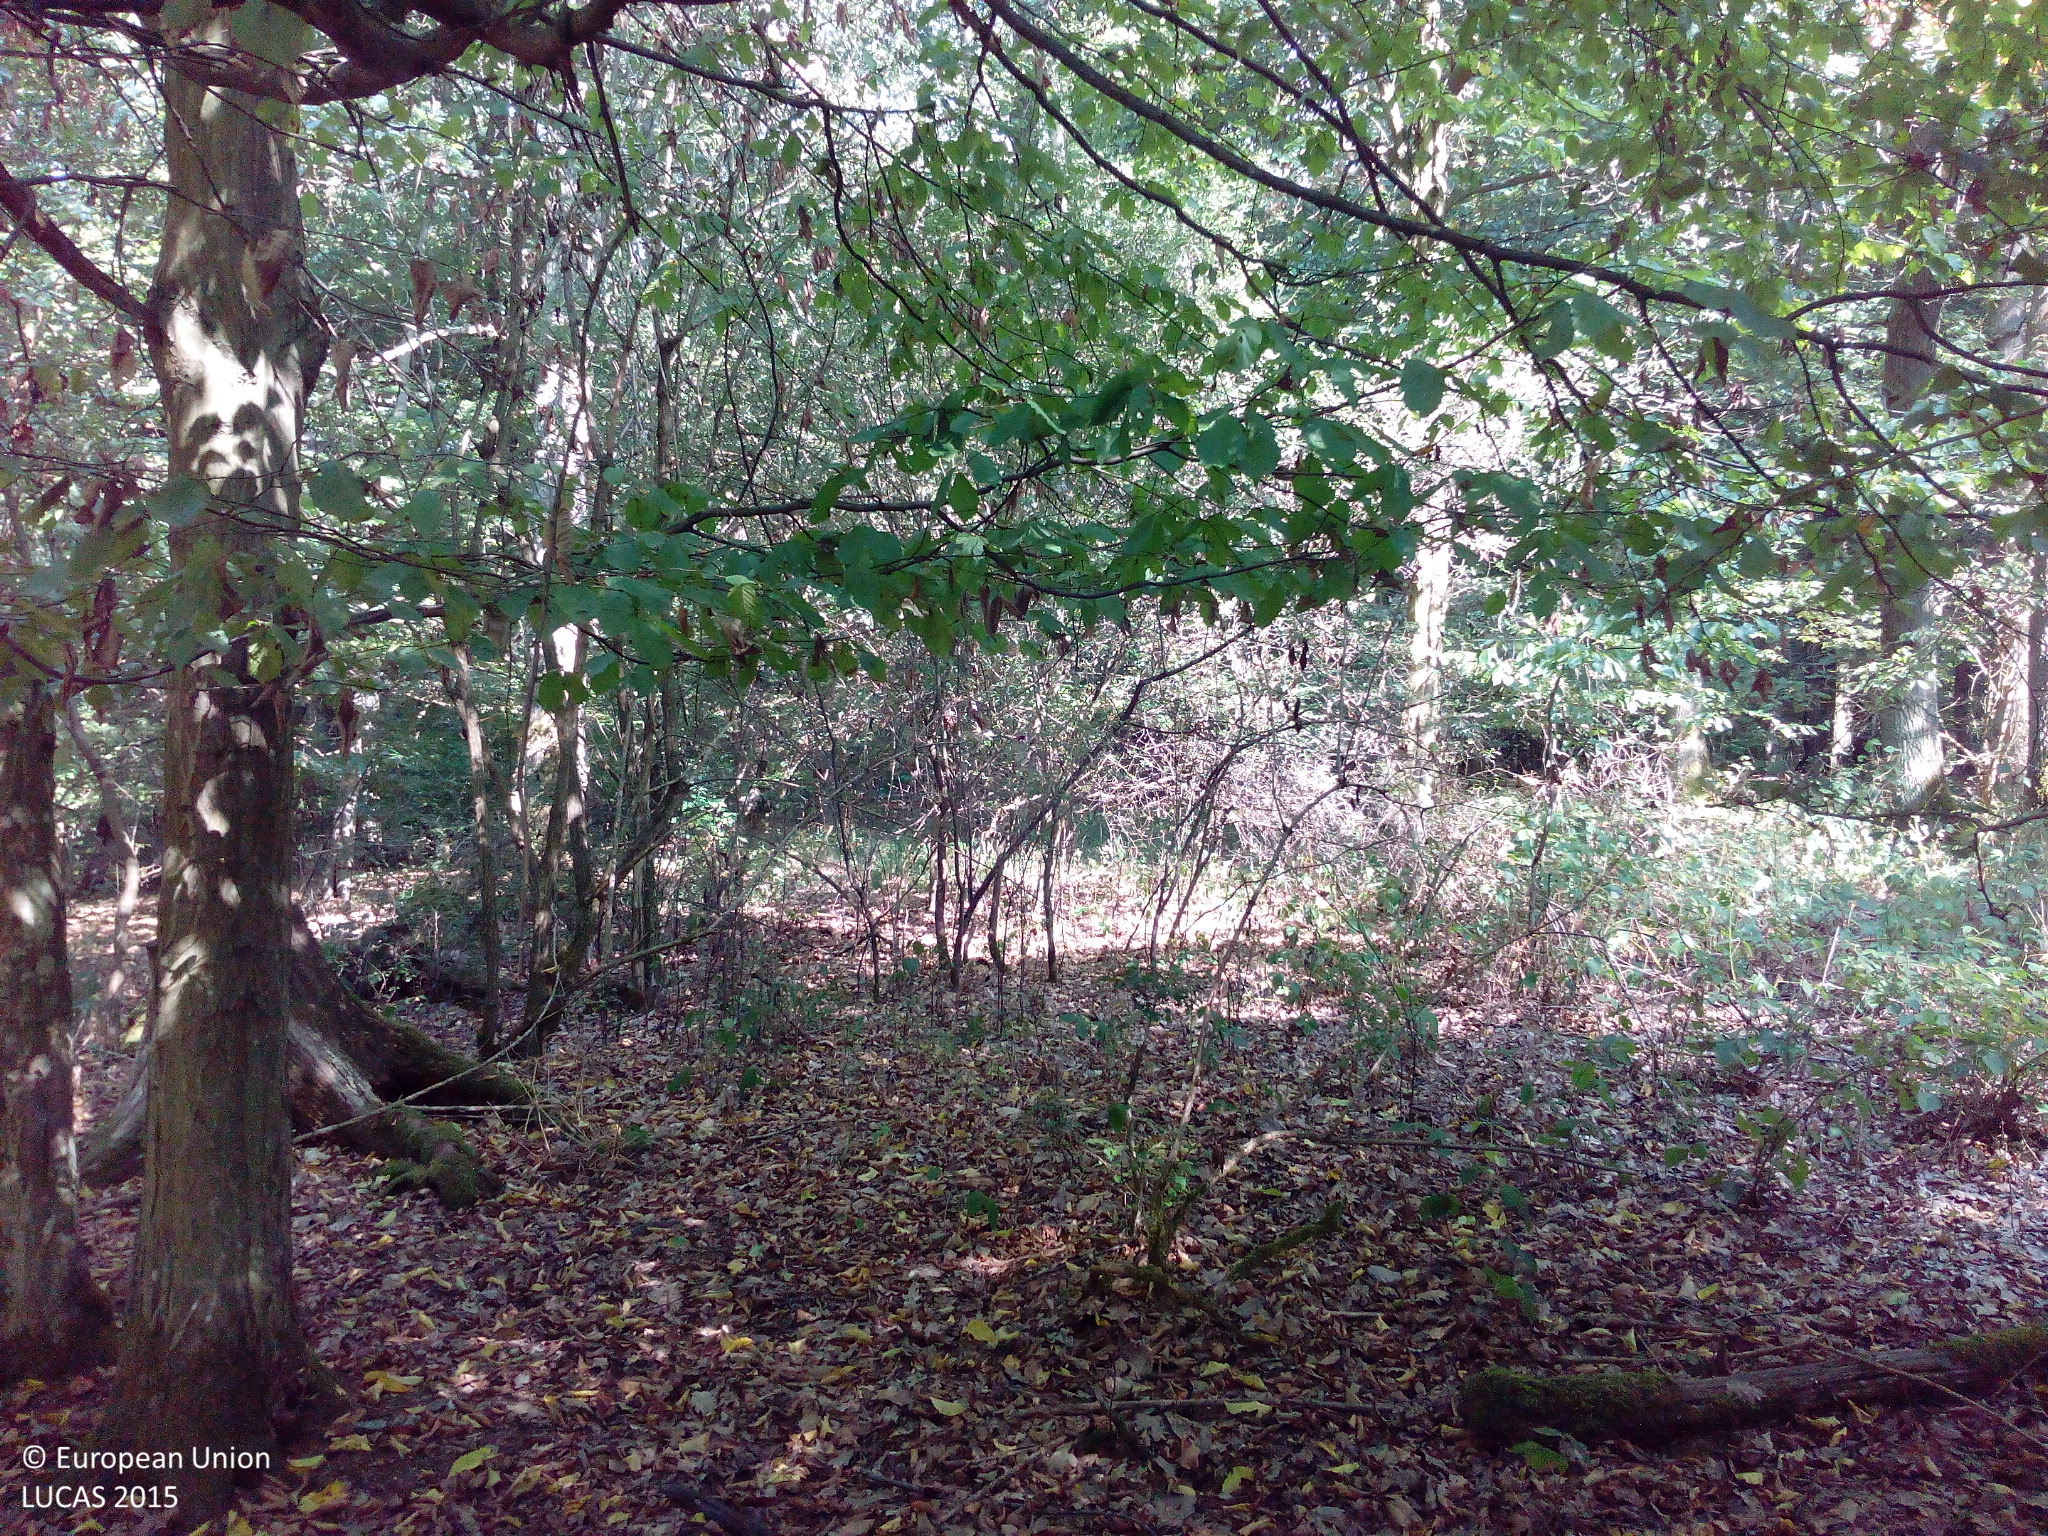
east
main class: Woodland
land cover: Broadleaved woodland
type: mesophytic deciduous forest
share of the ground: > 75 %
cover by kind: broadleaved forest trees 75 %, shrubs 10 %, unconsolidated bare surface 10 %, coniferous forest trees 5 %
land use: Forestry
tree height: > 5 m
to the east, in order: Broadleaved woodland; Tracks; Other coniferous woodland; Other mixed woodland
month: August
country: DE
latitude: 50.1741
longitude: 7.4659
